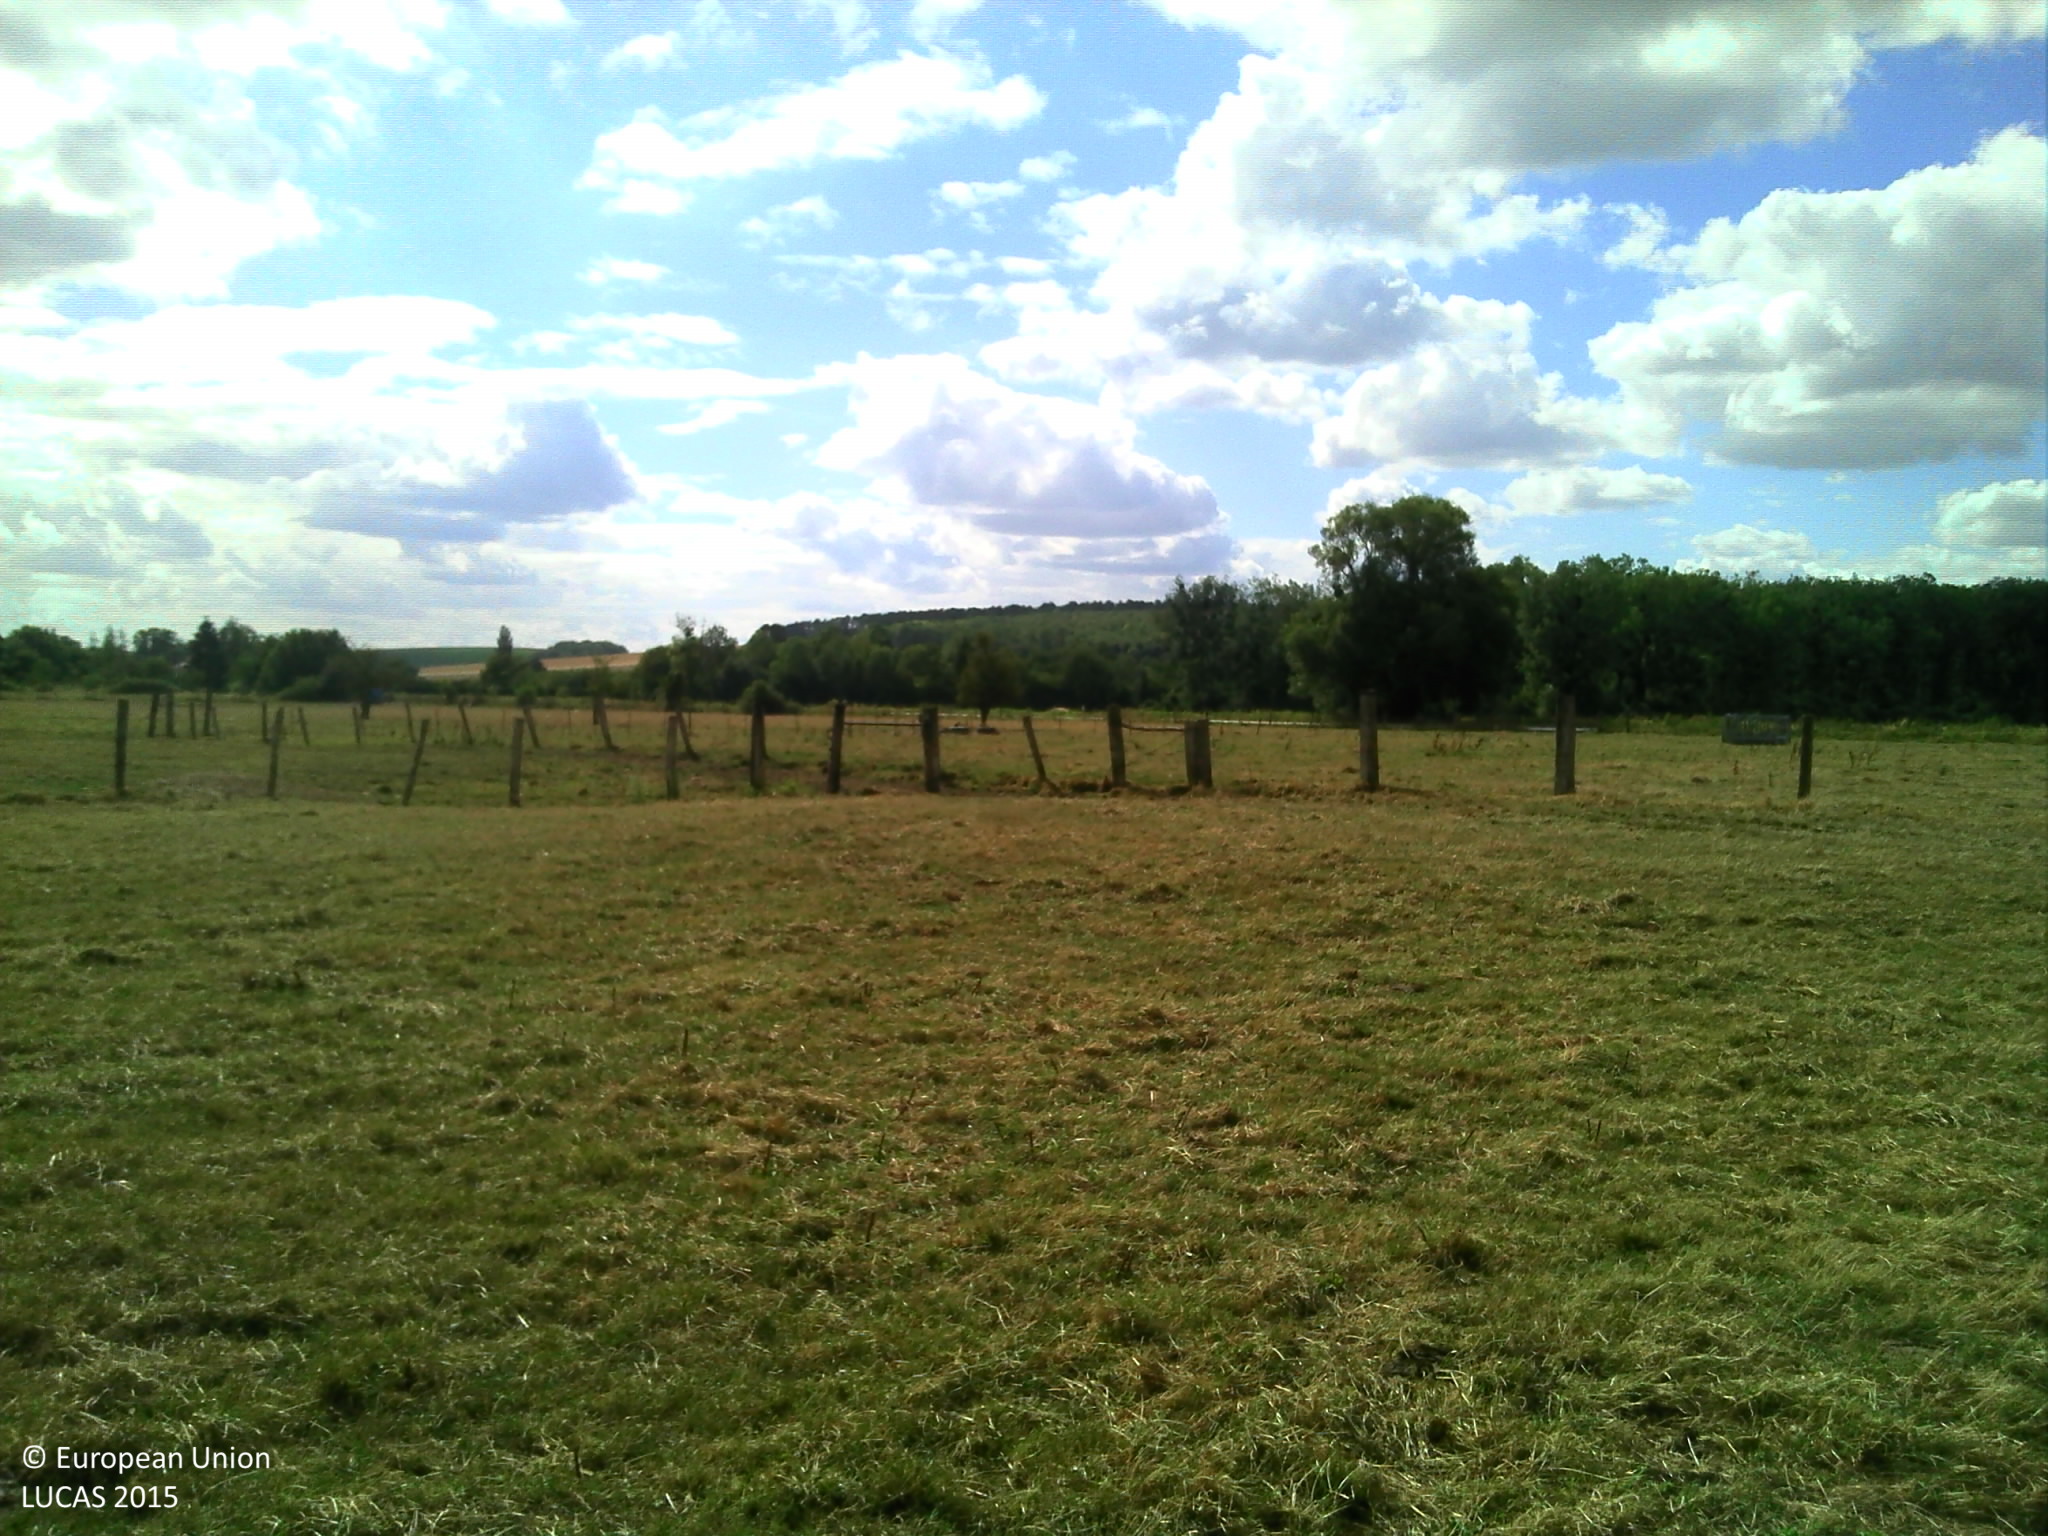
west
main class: Grassland
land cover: Grassland without tree/shrub cover
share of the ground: > 75 %
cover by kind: herbaceous plants 100 %
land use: Agriculture (excluding fallow land and kitchen gardens)
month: July
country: FR
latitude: 49.2222
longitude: 5.2889
